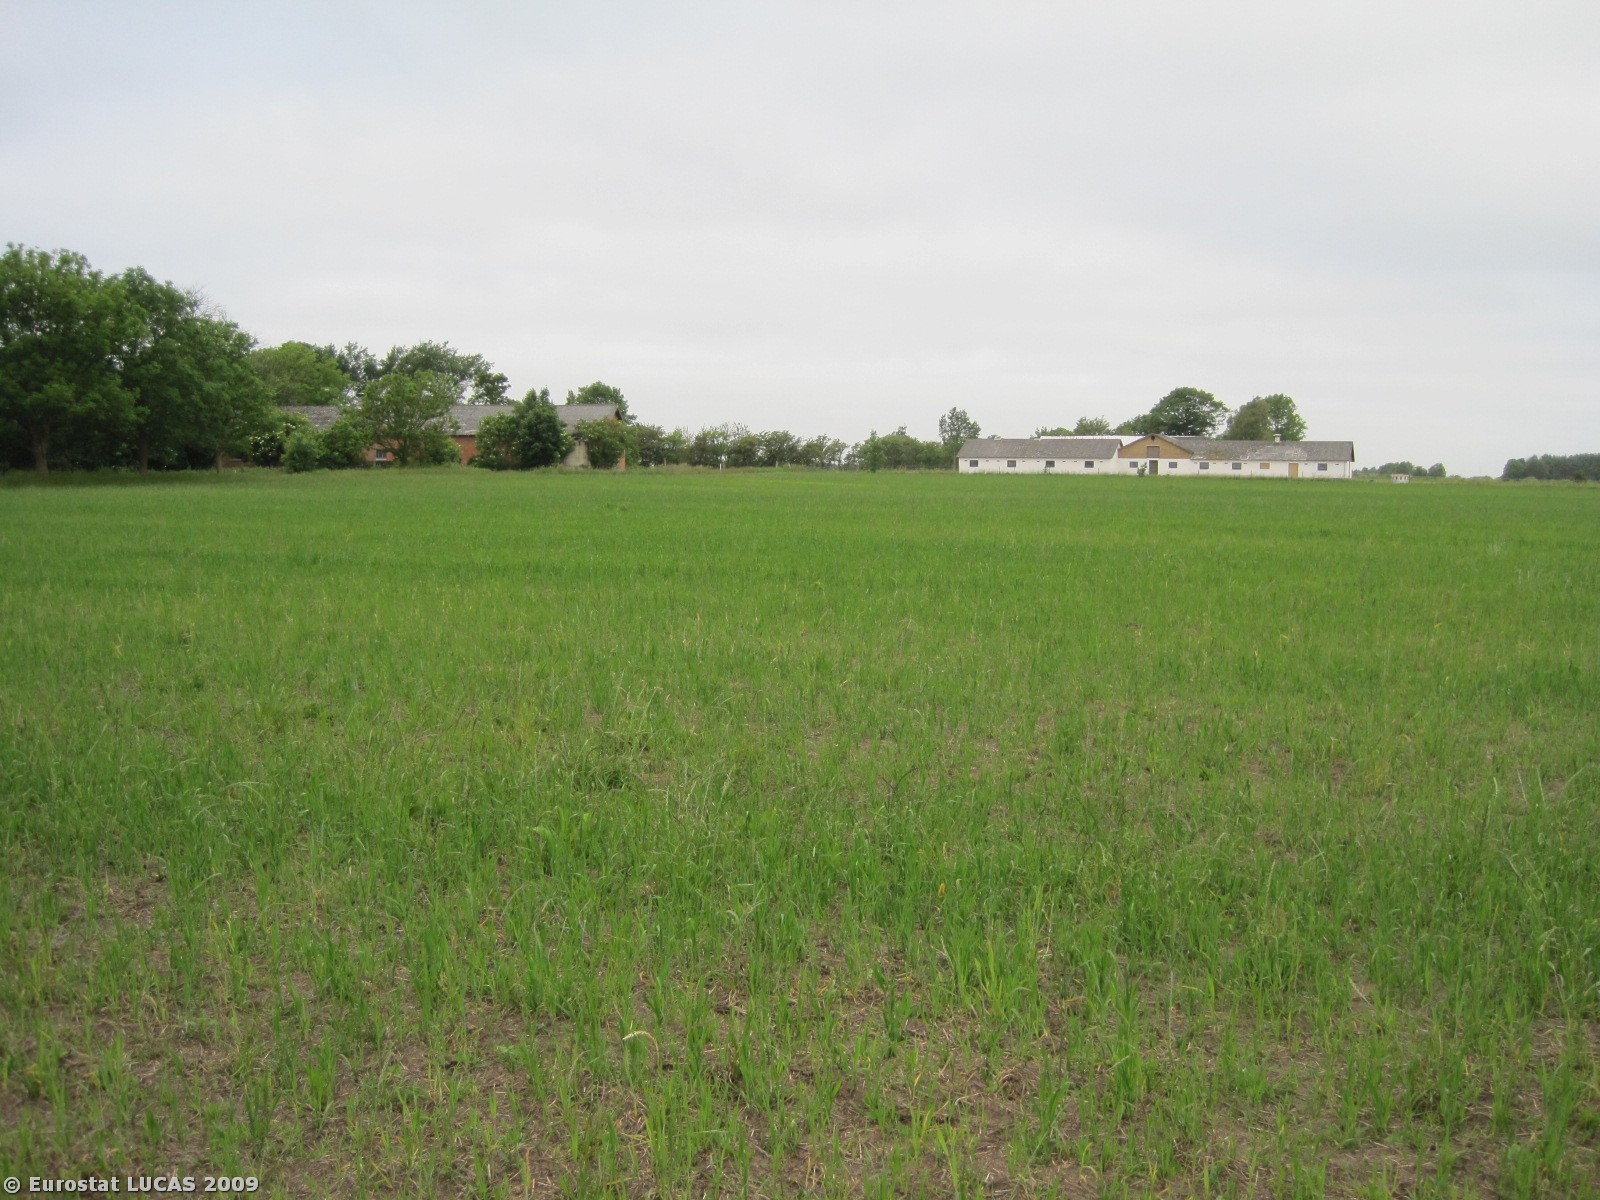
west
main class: Cropland
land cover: Rye
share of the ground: 50 - 75 %
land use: Agriculture (excluding fallow land and kitchen gardens)
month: June
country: DK
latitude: 57.1585
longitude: 10.0495
